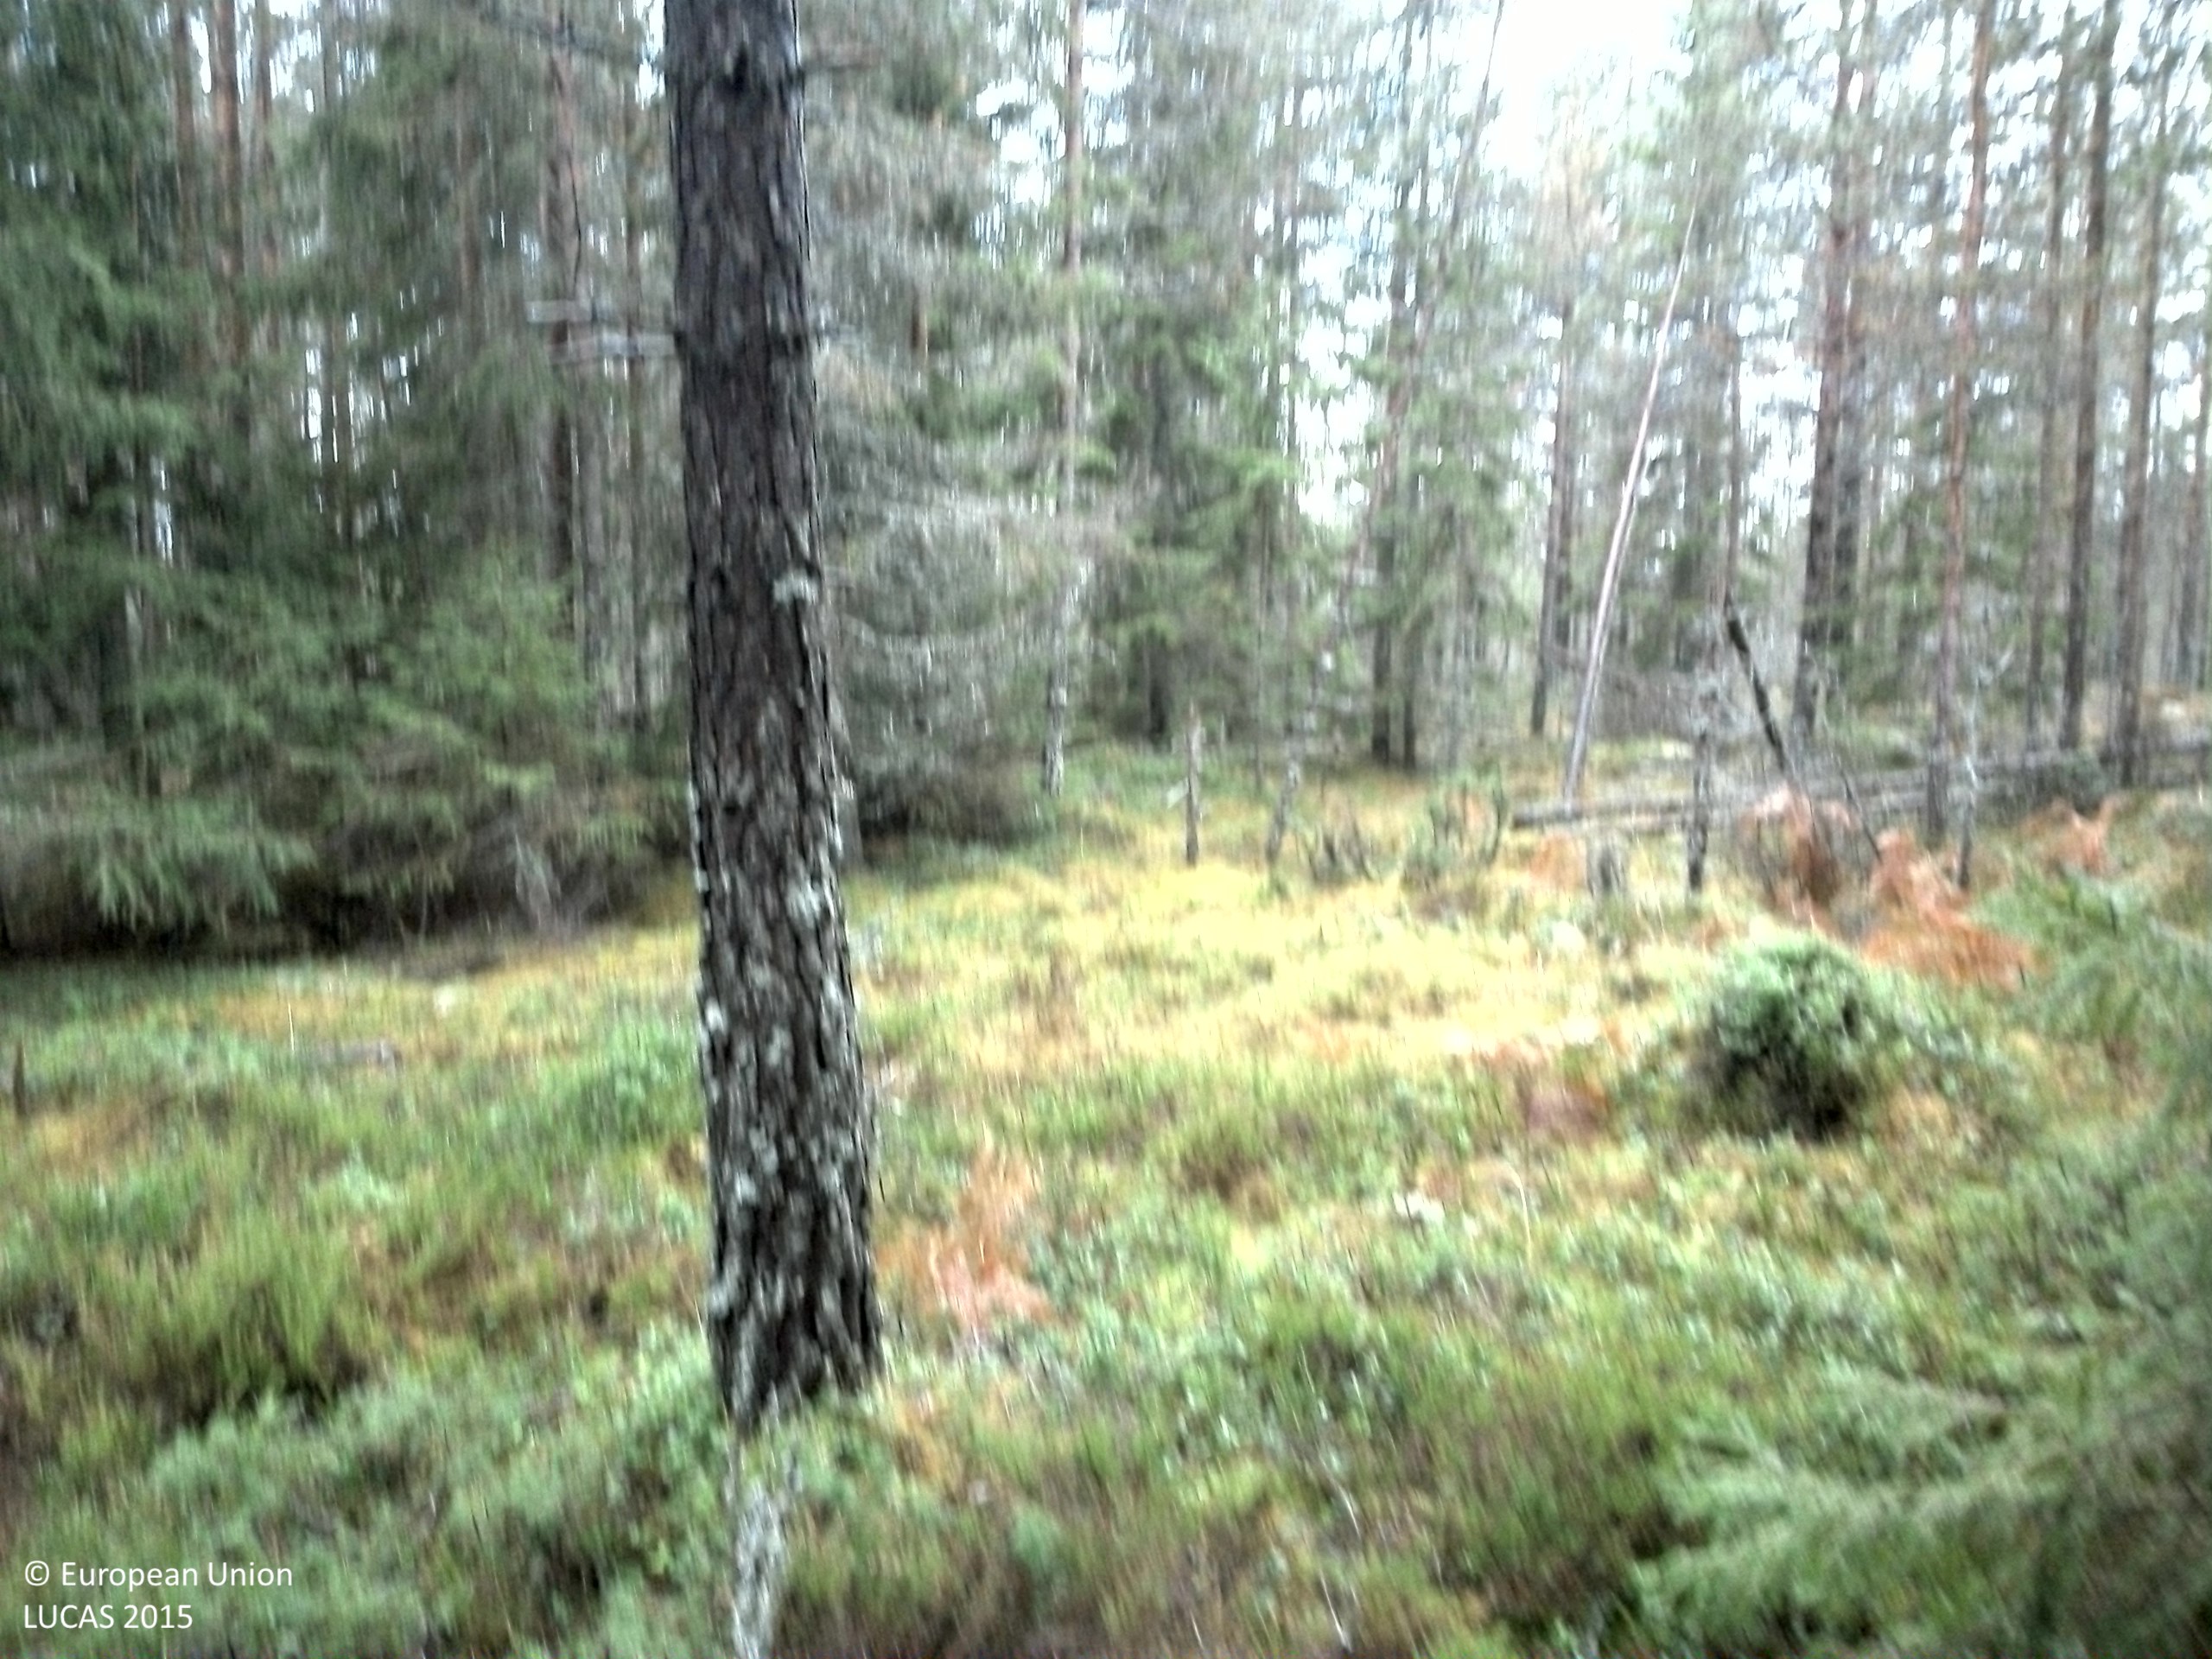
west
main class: Woodland
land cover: Pine dominated coniferous woodland
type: boreal forest
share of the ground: > 75 %
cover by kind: coniferous forest trees 75 %, shrubs 15 %, herbaceous plants 5 %, lichens and mosses 5 %
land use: Forestry
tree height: > 5 m
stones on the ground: 10 - 25 %
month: November
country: SE
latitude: 59.9545
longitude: 15.3075
